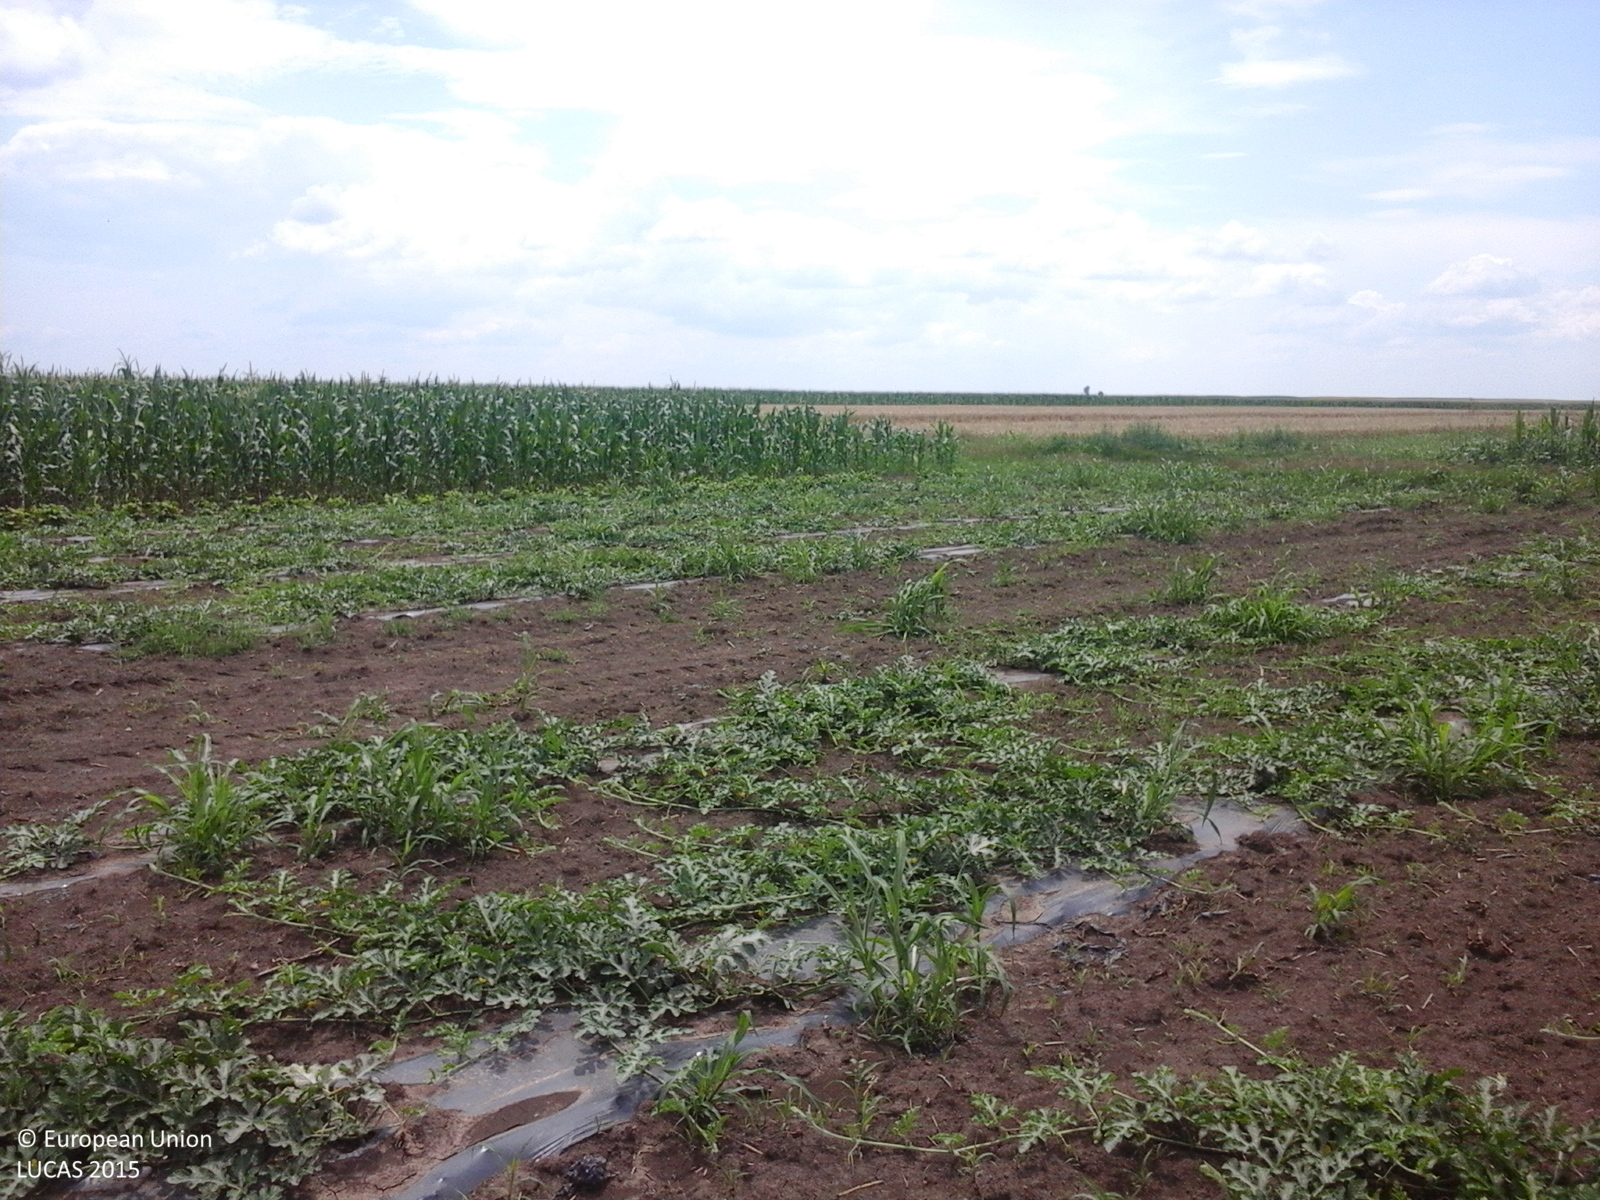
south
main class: Cropland
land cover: Other fresh vegetables
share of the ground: 50 - 75 %
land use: Agriculture (excluding fallow land and kitchen gardens)
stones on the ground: < 10 %
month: July
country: RO
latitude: 44.0530
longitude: 24.5343
